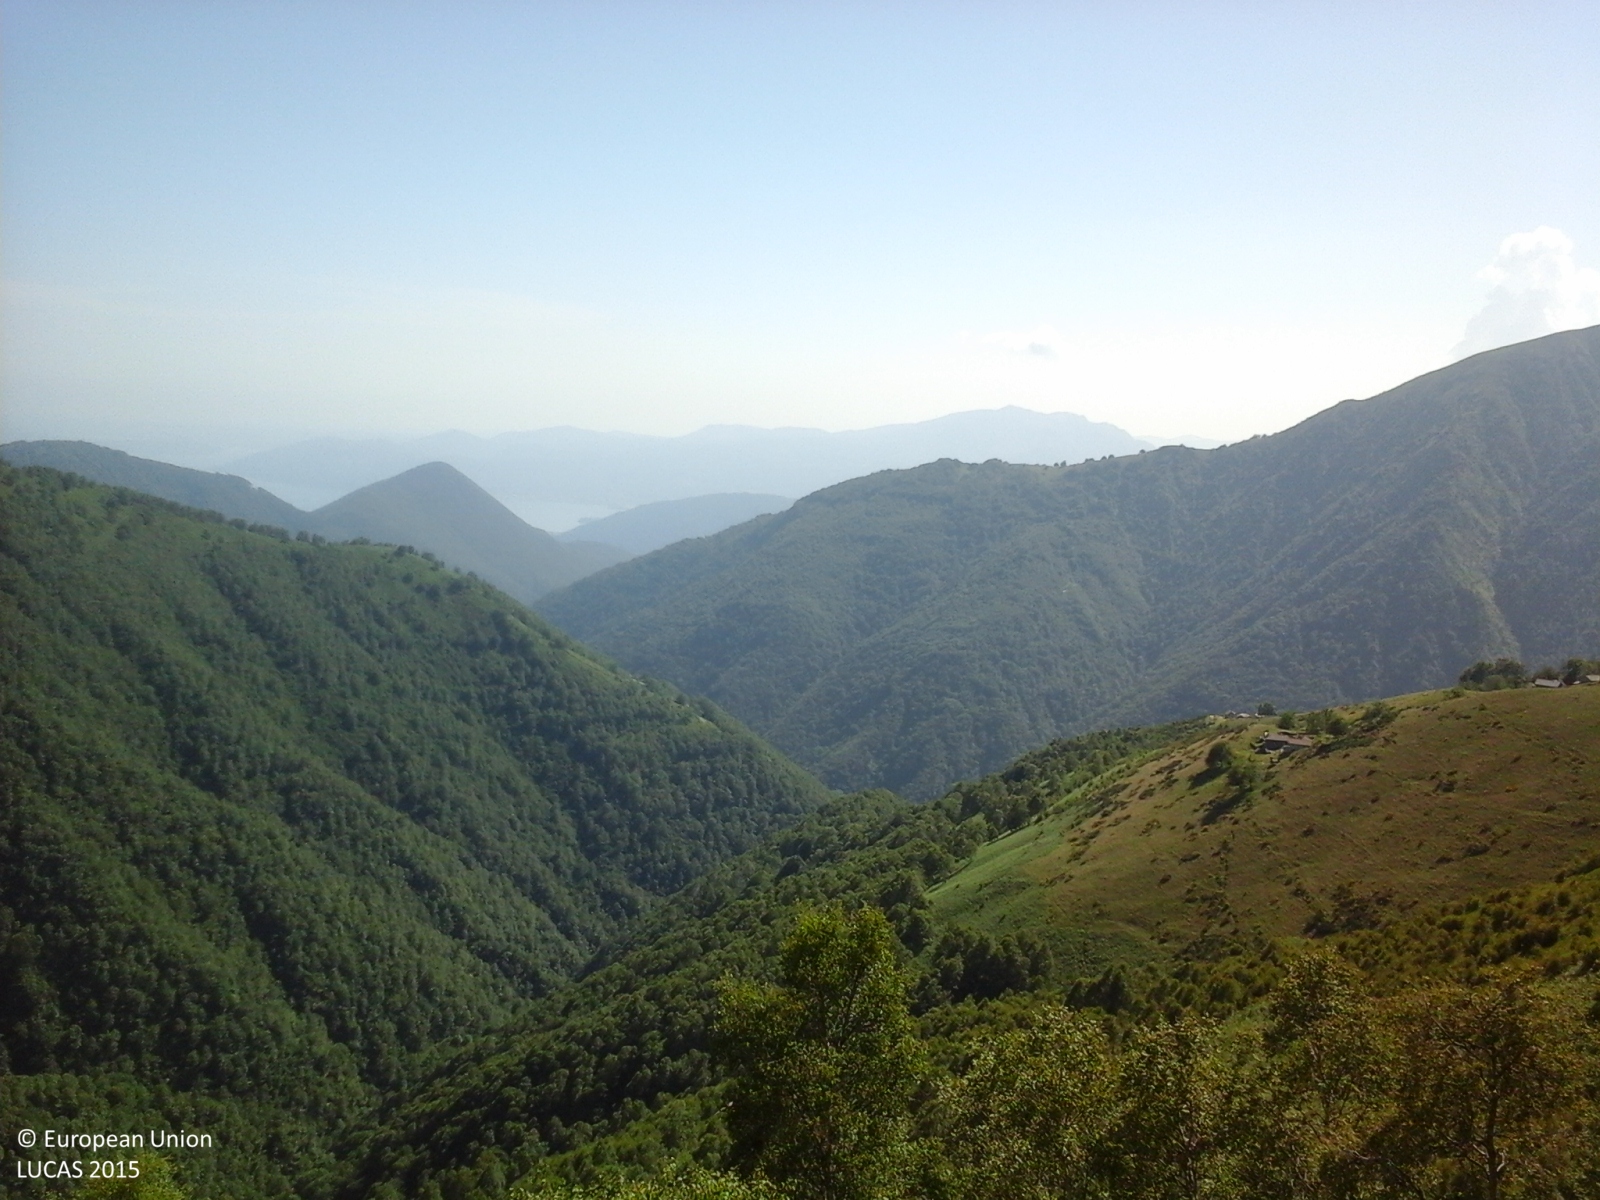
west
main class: Grassland
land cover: Grassland with sparse tree/shrub cover
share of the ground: > 75 %
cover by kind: herbaceous plants 95 %, broadleaved forest trees 5 %
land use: Semi-natural and natural areas not in use
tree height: > 5 m
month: June
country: IT
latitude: 46.0357
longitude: 8.5936
